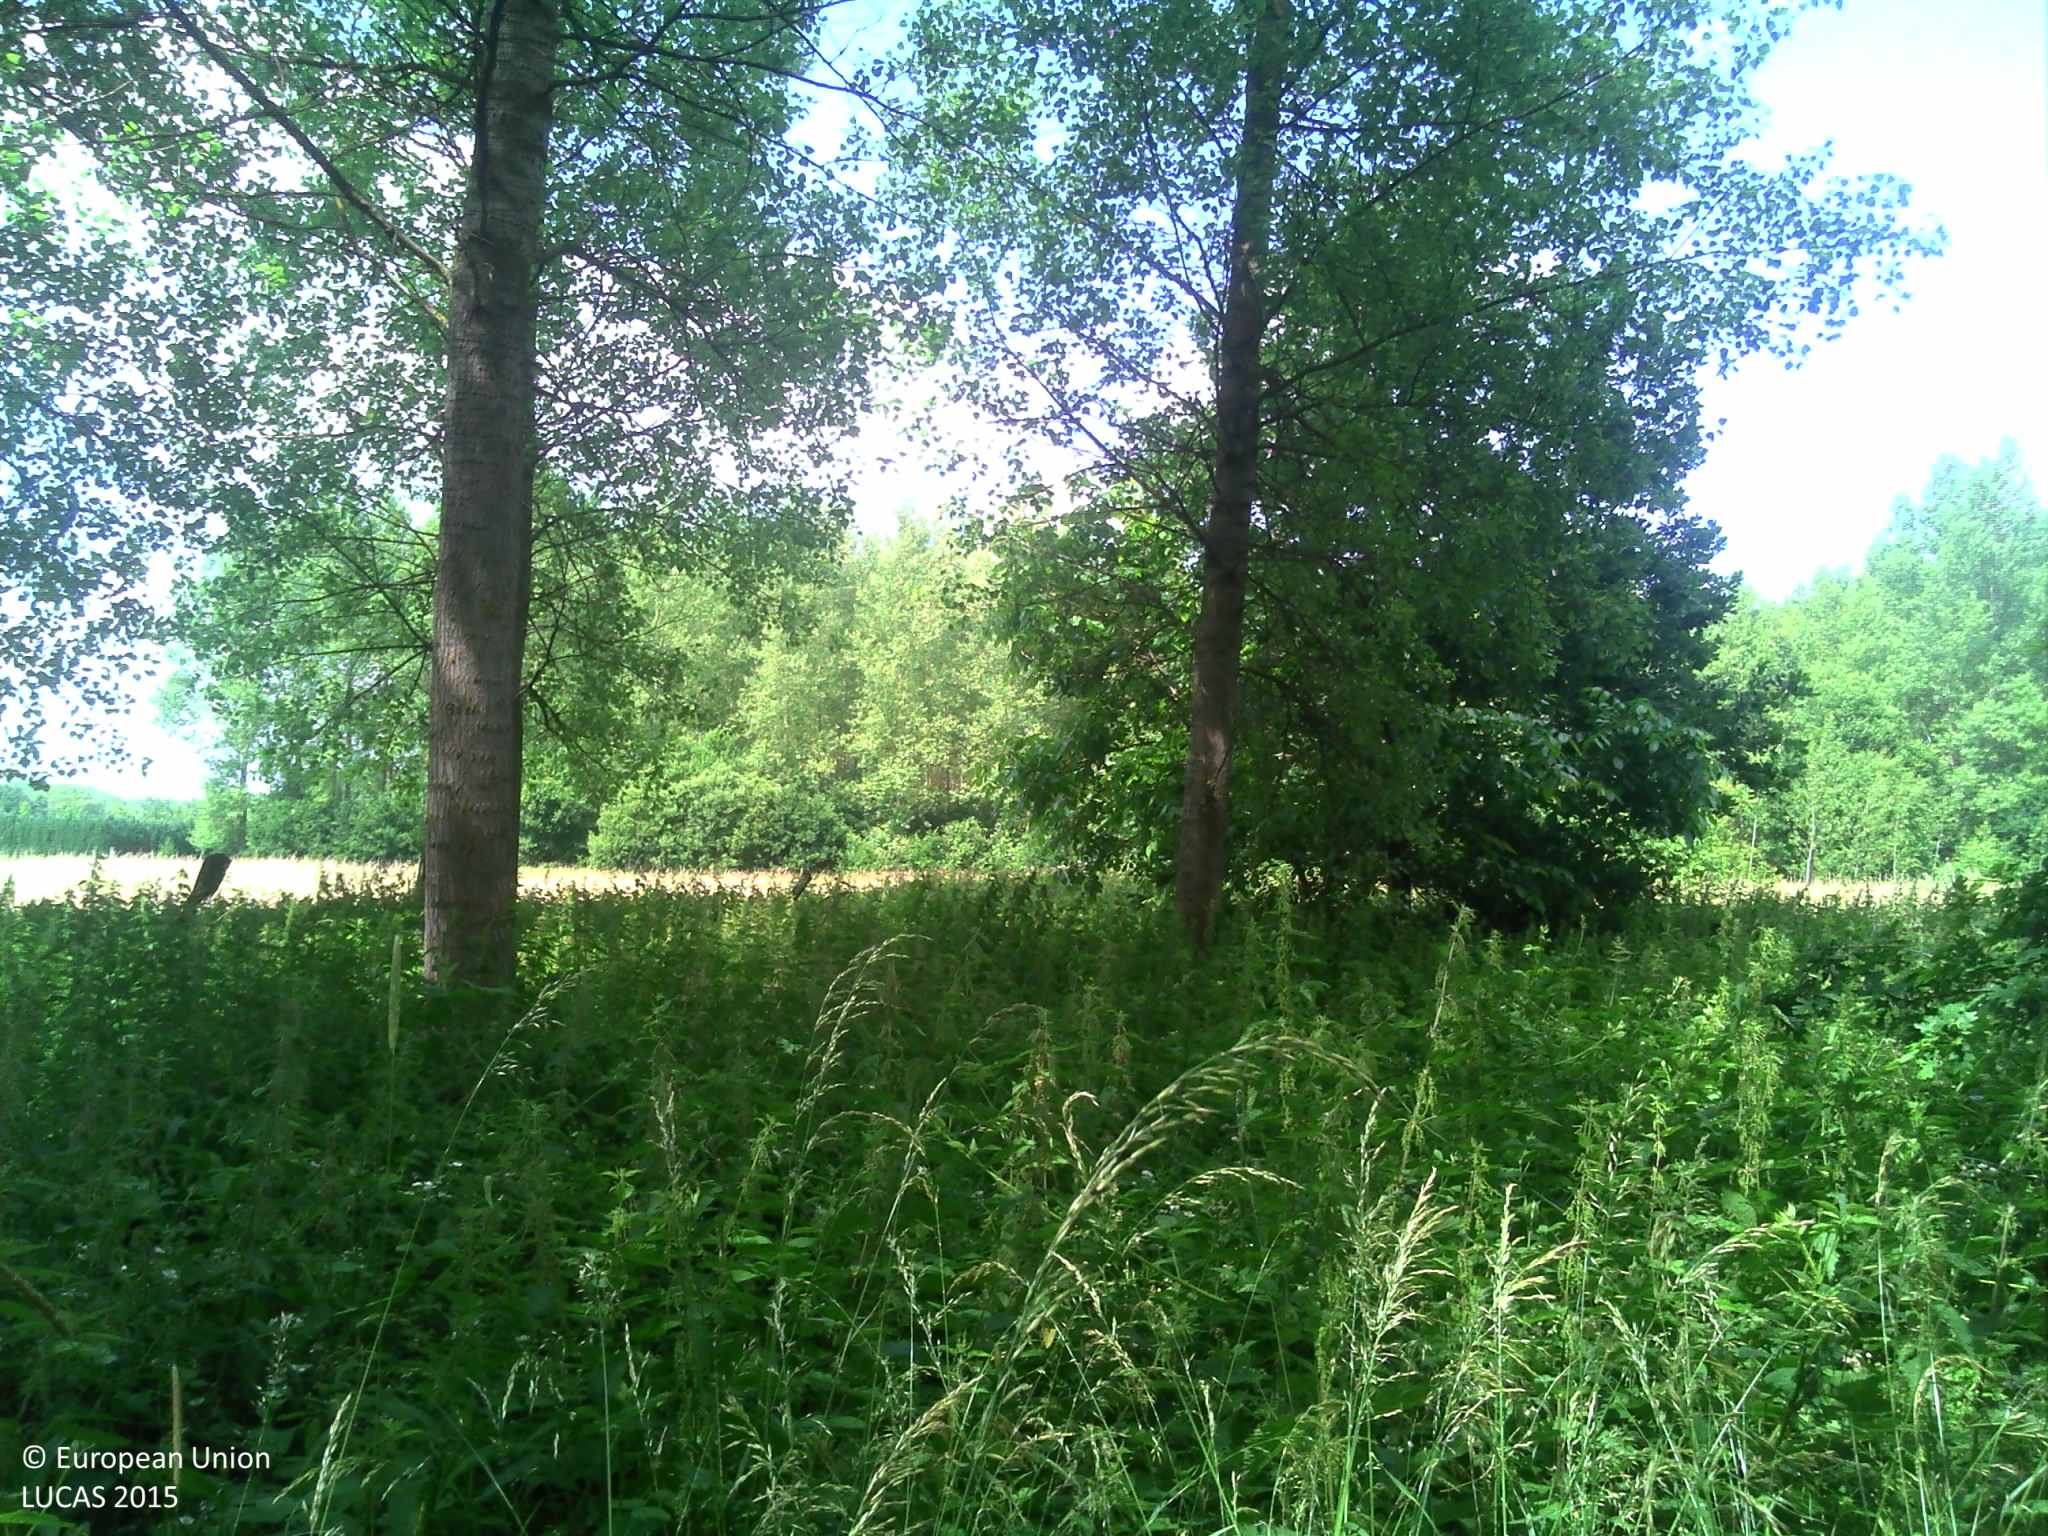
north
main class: Woodland
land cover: Broadleaved woodland
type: exotic forest
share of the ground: > 75 %
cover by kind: broadleaved forest trees 85 %, shrubs 10 %, herbaceous plants 5 %
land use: Forestry
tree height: > 5 m
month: June
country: BE
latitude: 50.9202
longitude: 4.5762
